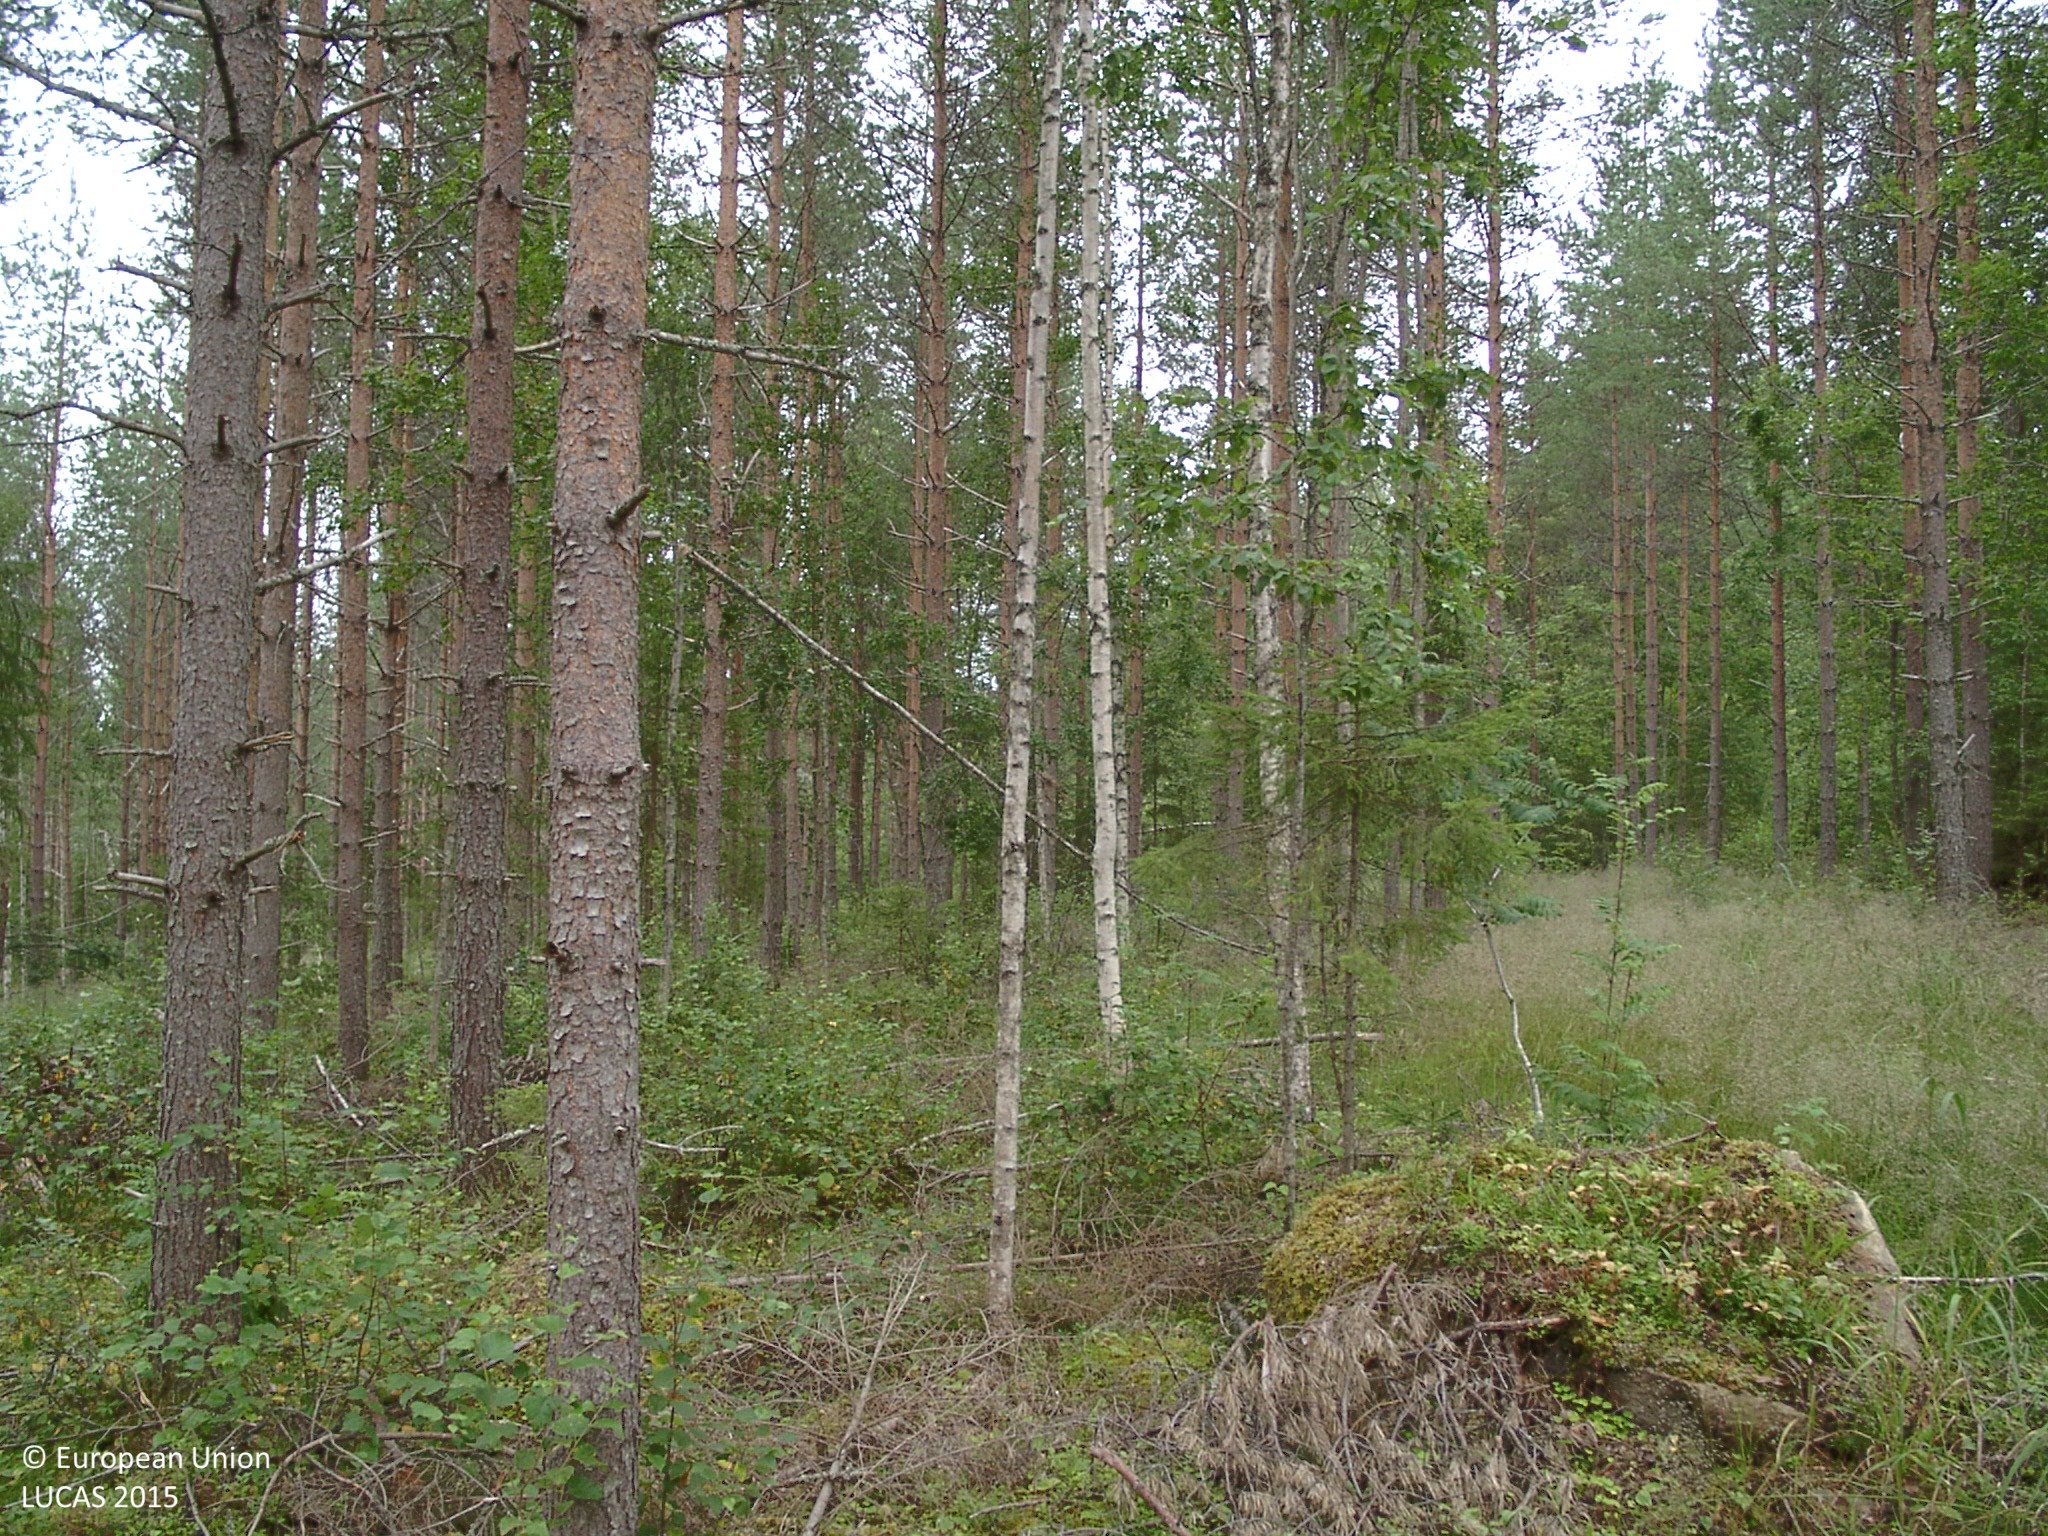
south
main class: Woodland
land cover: Pine dominated mixed woodland
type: boreal forest
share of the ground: 50 - 75 %
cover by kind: coniferous forest trees 45 %, broadleaved forest trees 20 %, shrubs 15 %, herbaceous plants 10 %, lichens and mosses 5 %
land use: Forestry
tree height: > 5 m
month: August
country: FI
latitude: 62.8553
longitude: 24.5672
